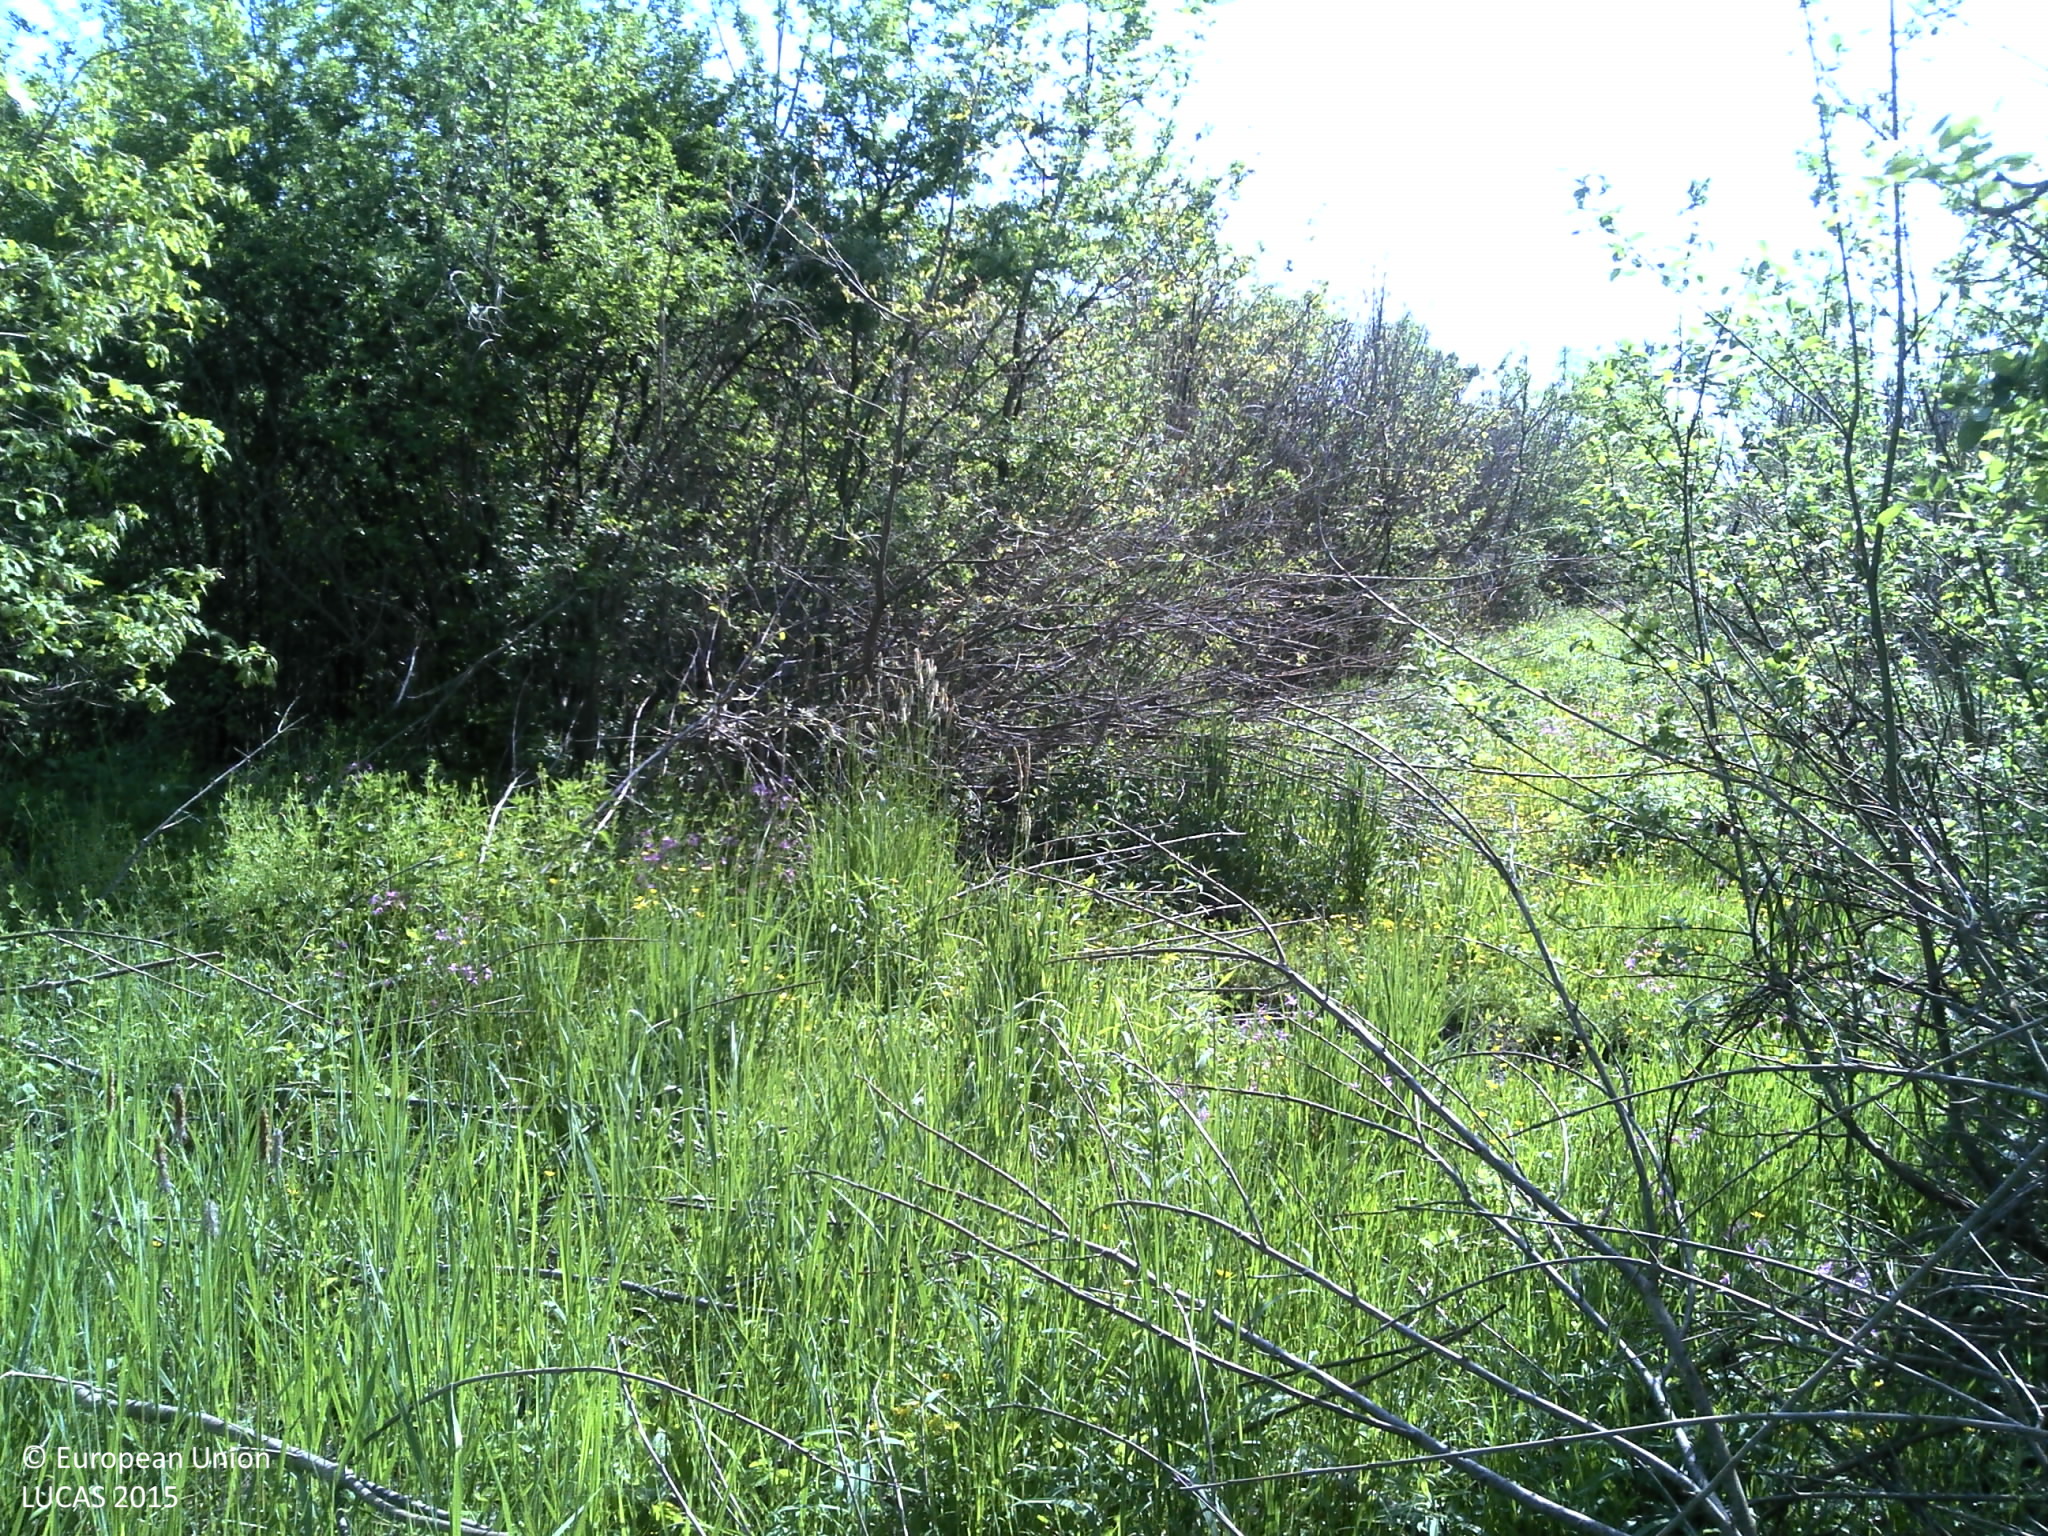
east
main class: Woodland
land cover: Broadleaved woodland
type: mesophytic deciduous forest
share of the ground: > 75 %
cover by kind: broadleaved forest trees 80 %, herbaceous plants 20 %
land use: Forestry
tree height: > 5 m
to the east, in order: Broadleaved woodland
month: May
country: HR
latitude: 45.2177
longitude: 18.4732
